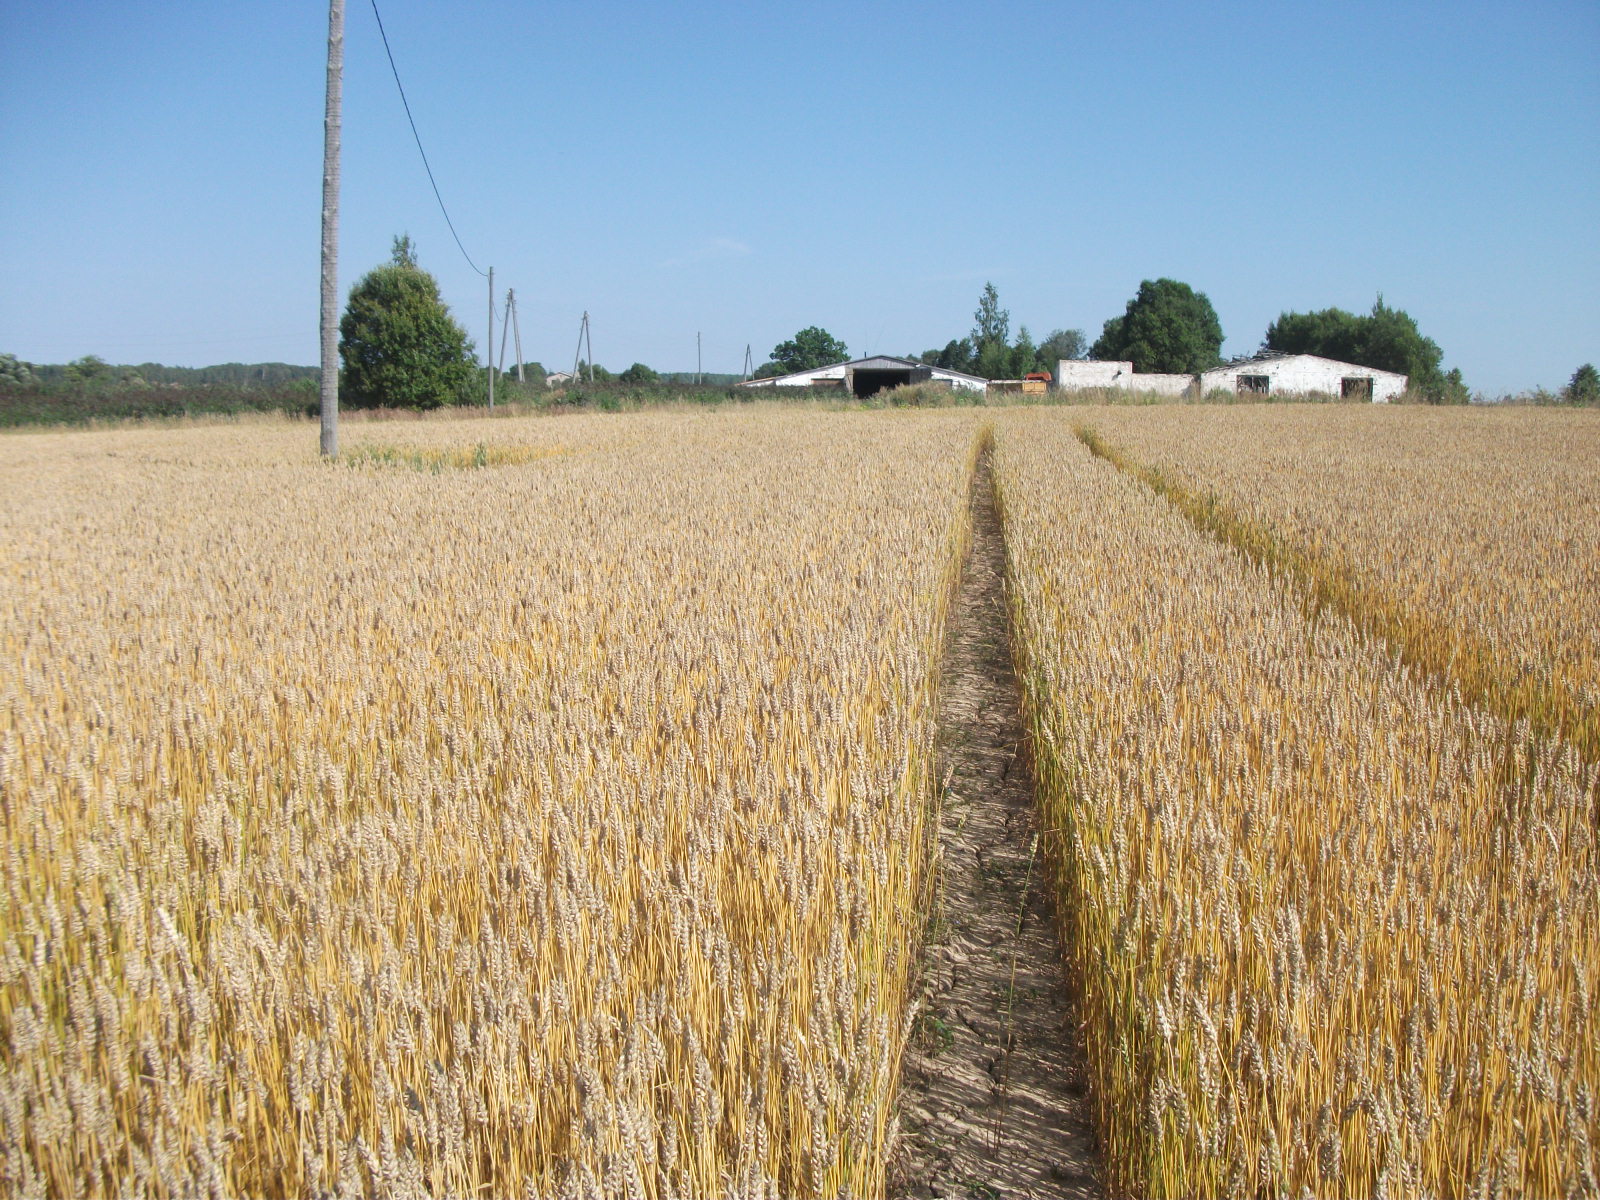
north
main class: Cropland
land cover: Common wheat
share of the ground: > 75 %
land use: Agriculture (excluding fallow land and kitchen gardens)
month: August
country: LV
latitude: 56.6974
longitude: 26.5943
